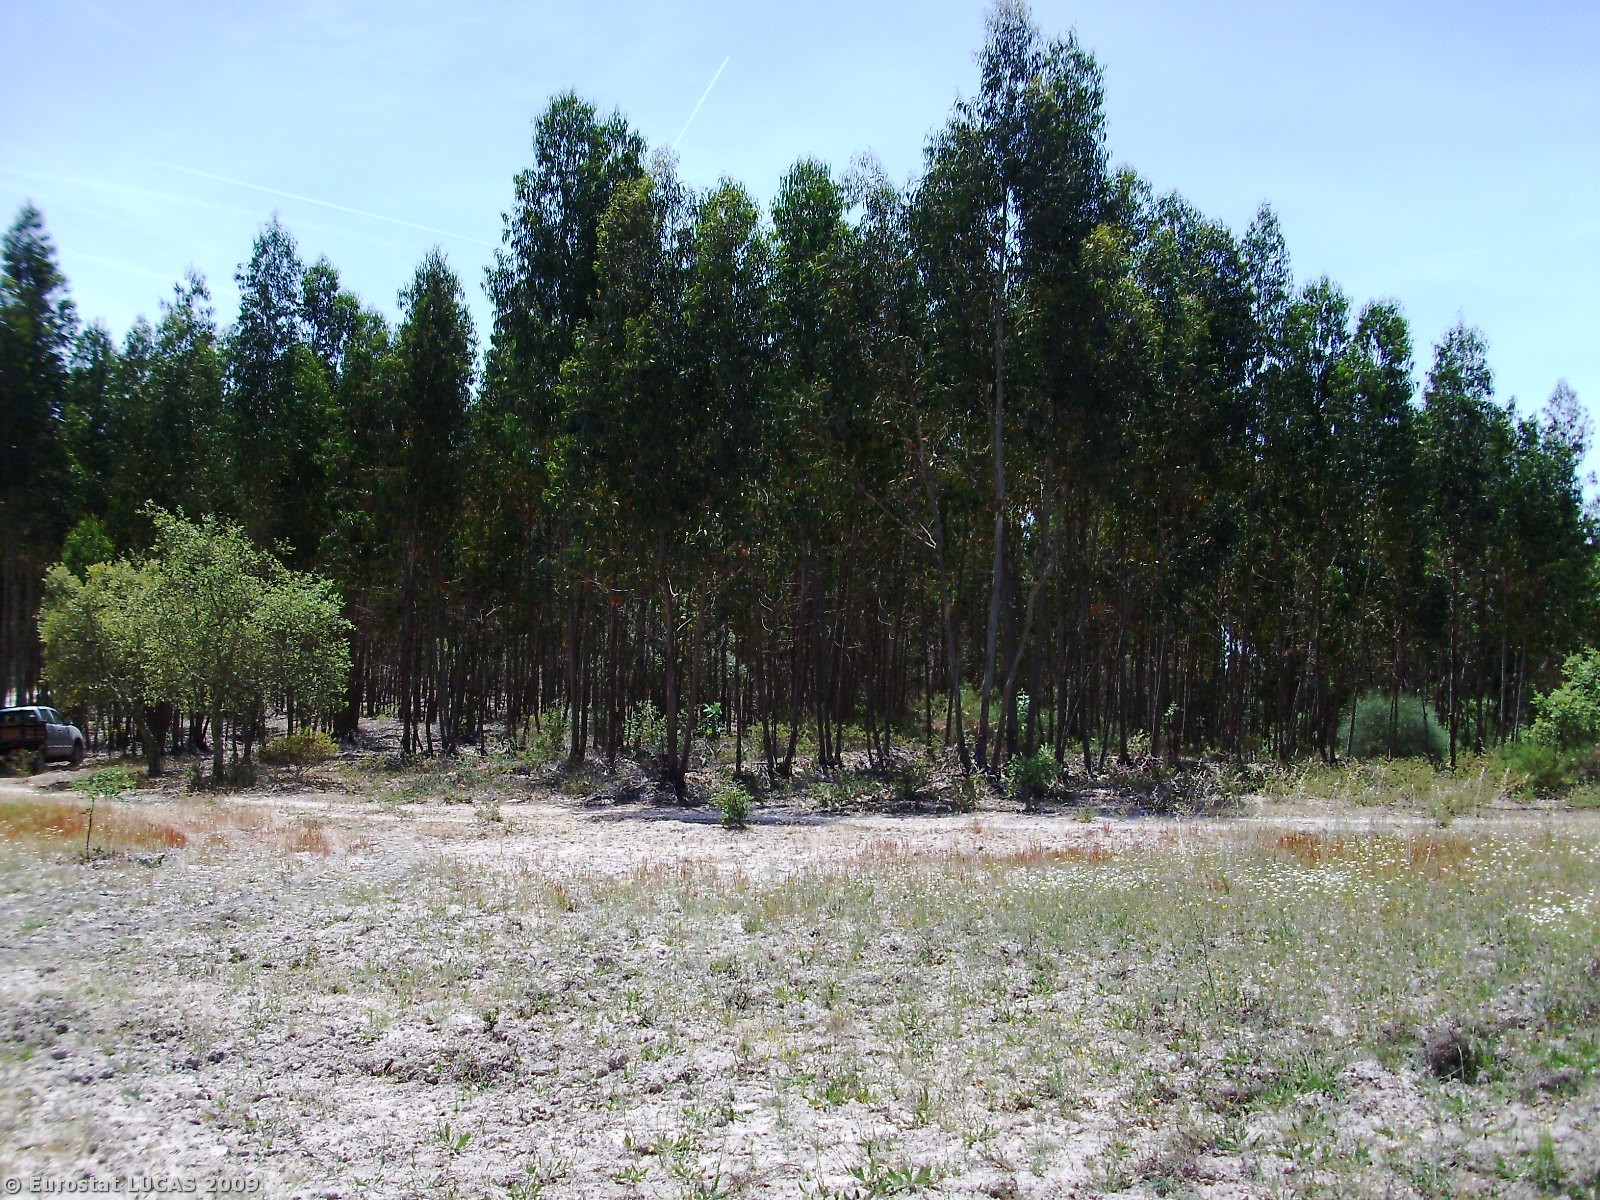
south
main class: Woodland
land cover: Broadleaved woodland
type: broadleaved evergreen forest
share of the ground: 50 - 75 %
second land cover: Bare land
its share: 25 - 50 %
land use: Forestry
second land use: Fallow land
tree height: > 5 m
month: May
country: PT
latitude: 39.1553
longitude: -8.0248
